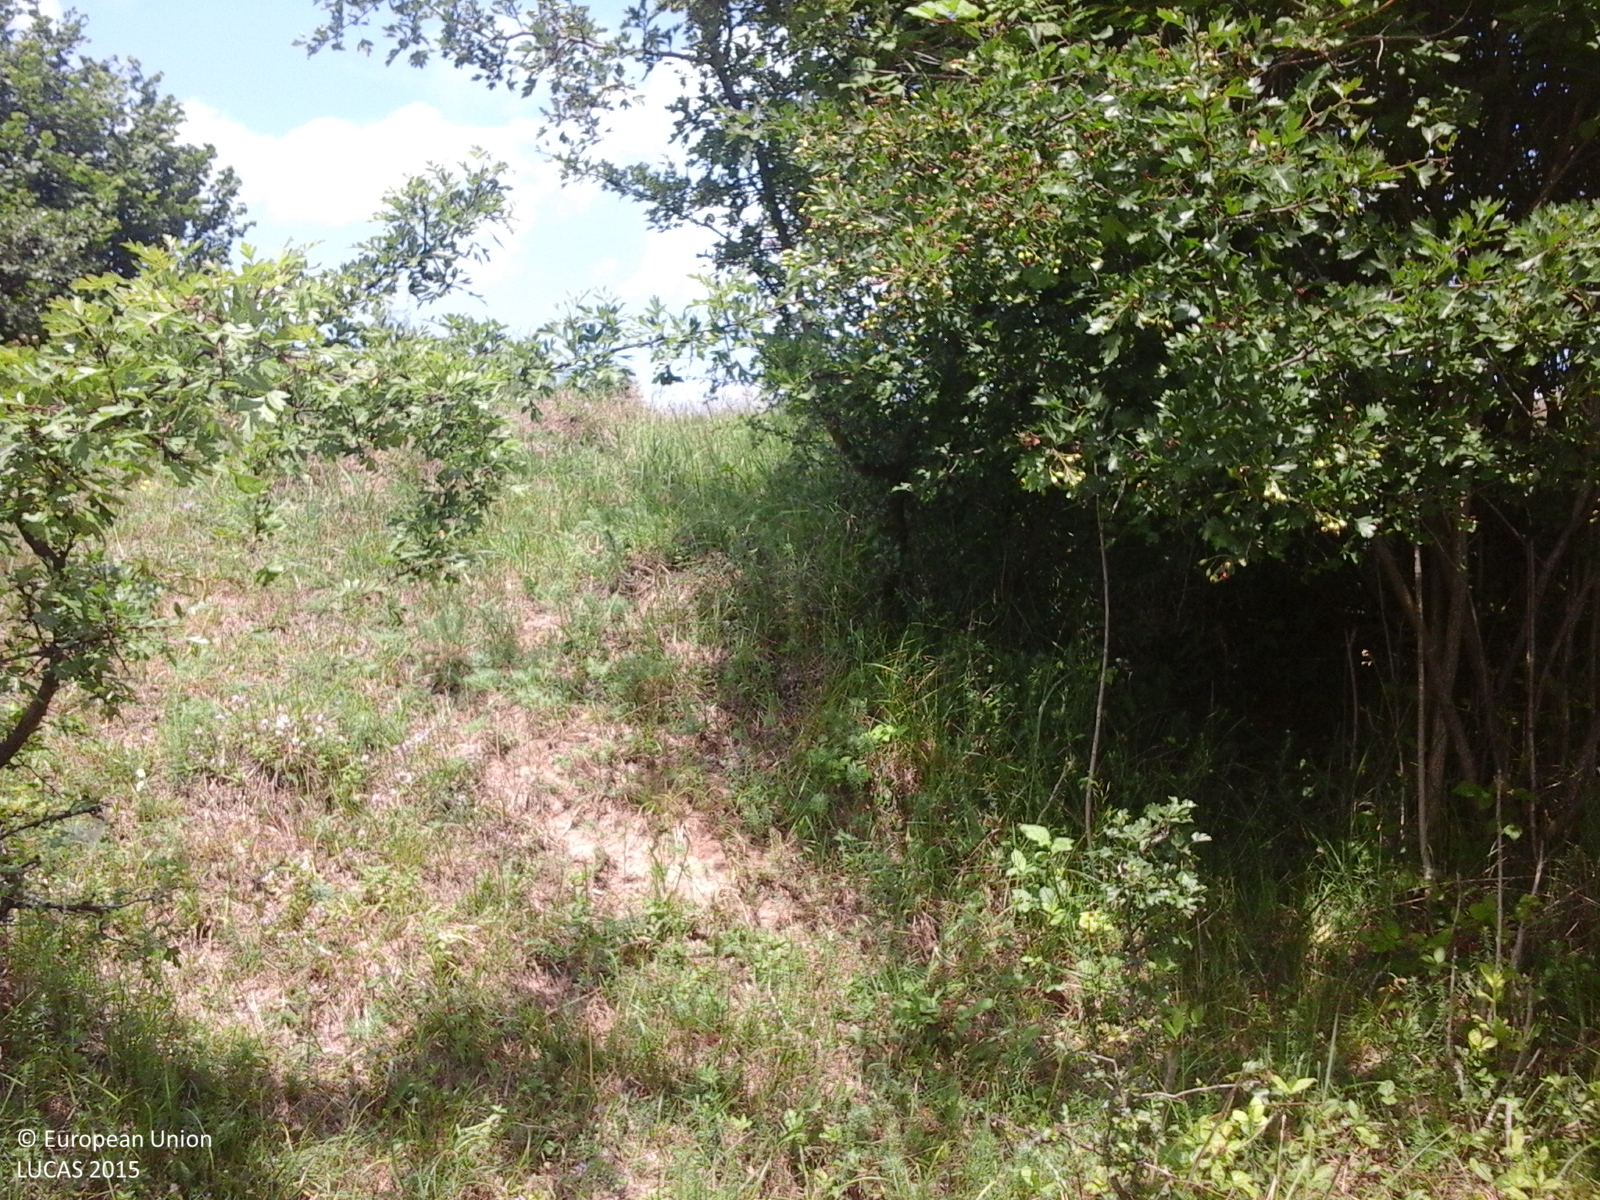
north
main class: Grassland
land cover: Grassland with sparse tree/shrub cover
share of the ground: > 75 %
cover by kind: herbaceous plants 85 %, shrubs 10 %, broadleaved forest trees 5 %
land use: Agriculture (excluding fallow land and kitchen gardens)
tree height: > 5 m
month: June
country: RO
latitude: 47.7805
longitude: 25.8623
